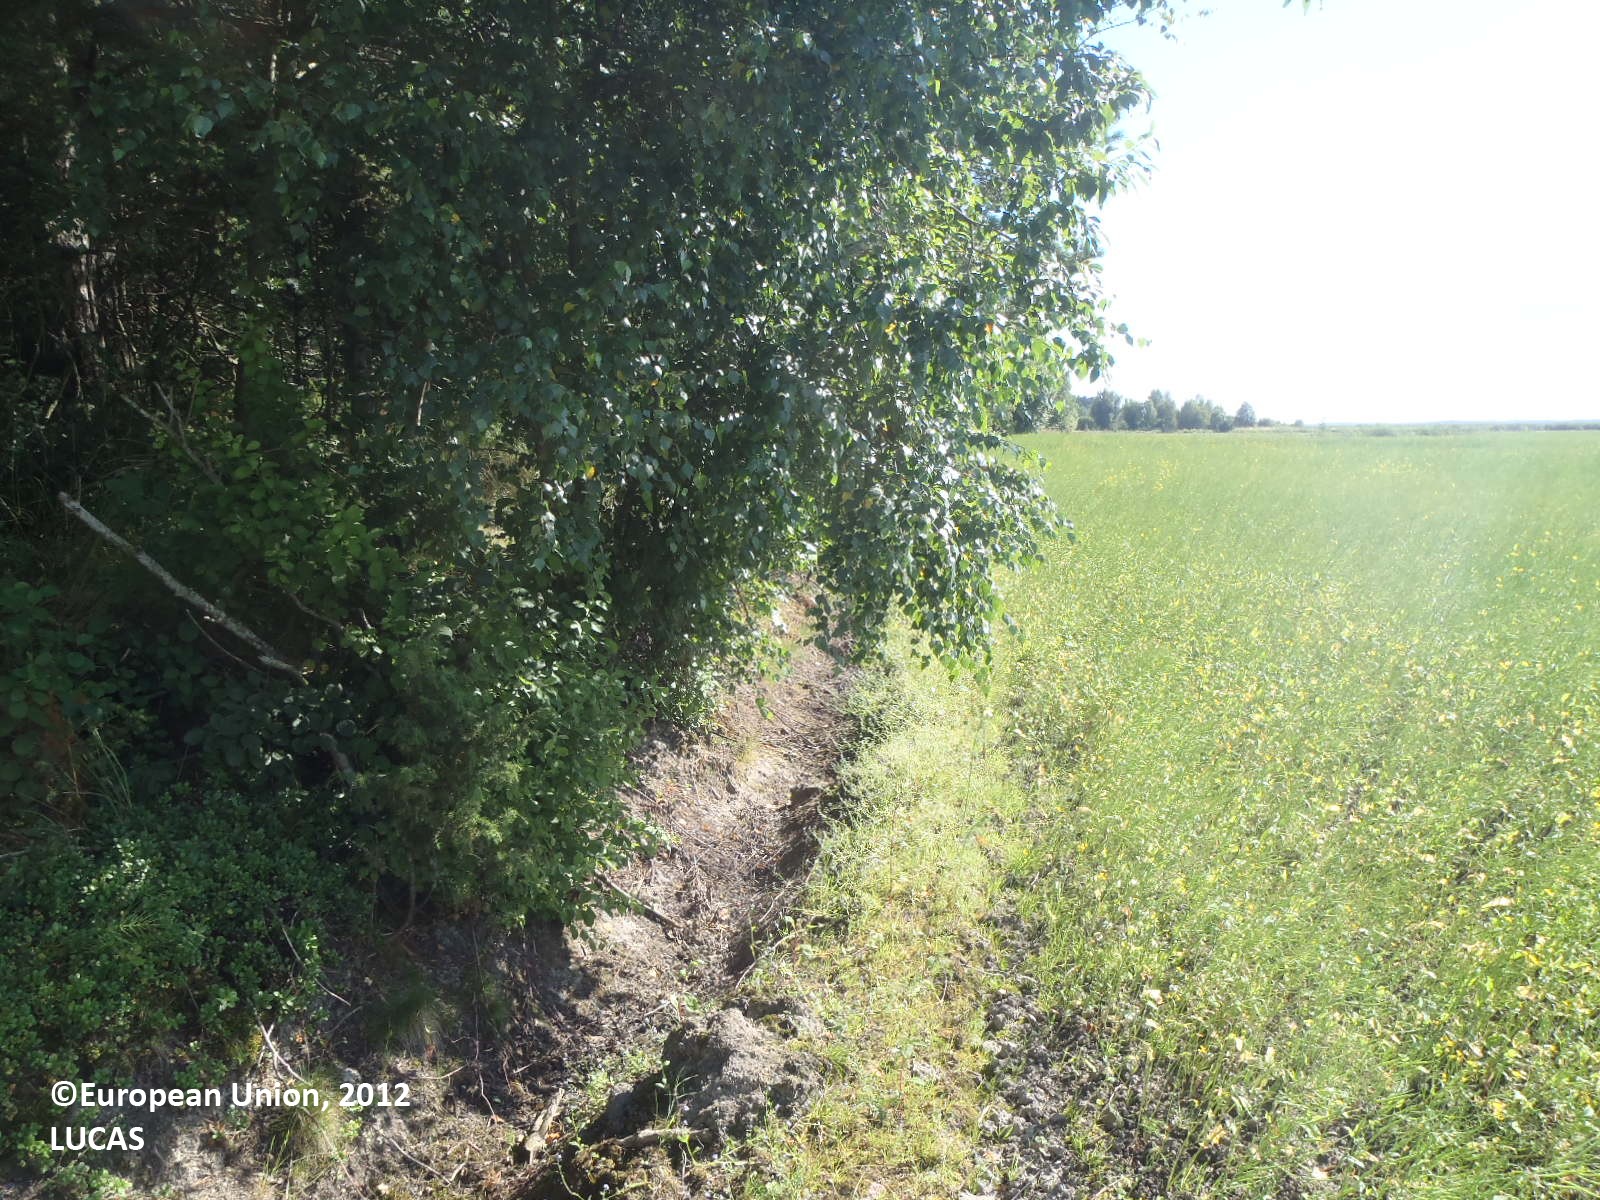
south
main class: Cropland
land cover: Rape and turnip rape
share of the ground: > 75 %
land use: Agriculture (excluding fallow land and kitchen gardens)
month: July
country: FI
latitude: 60.6452
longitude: 21.8556
